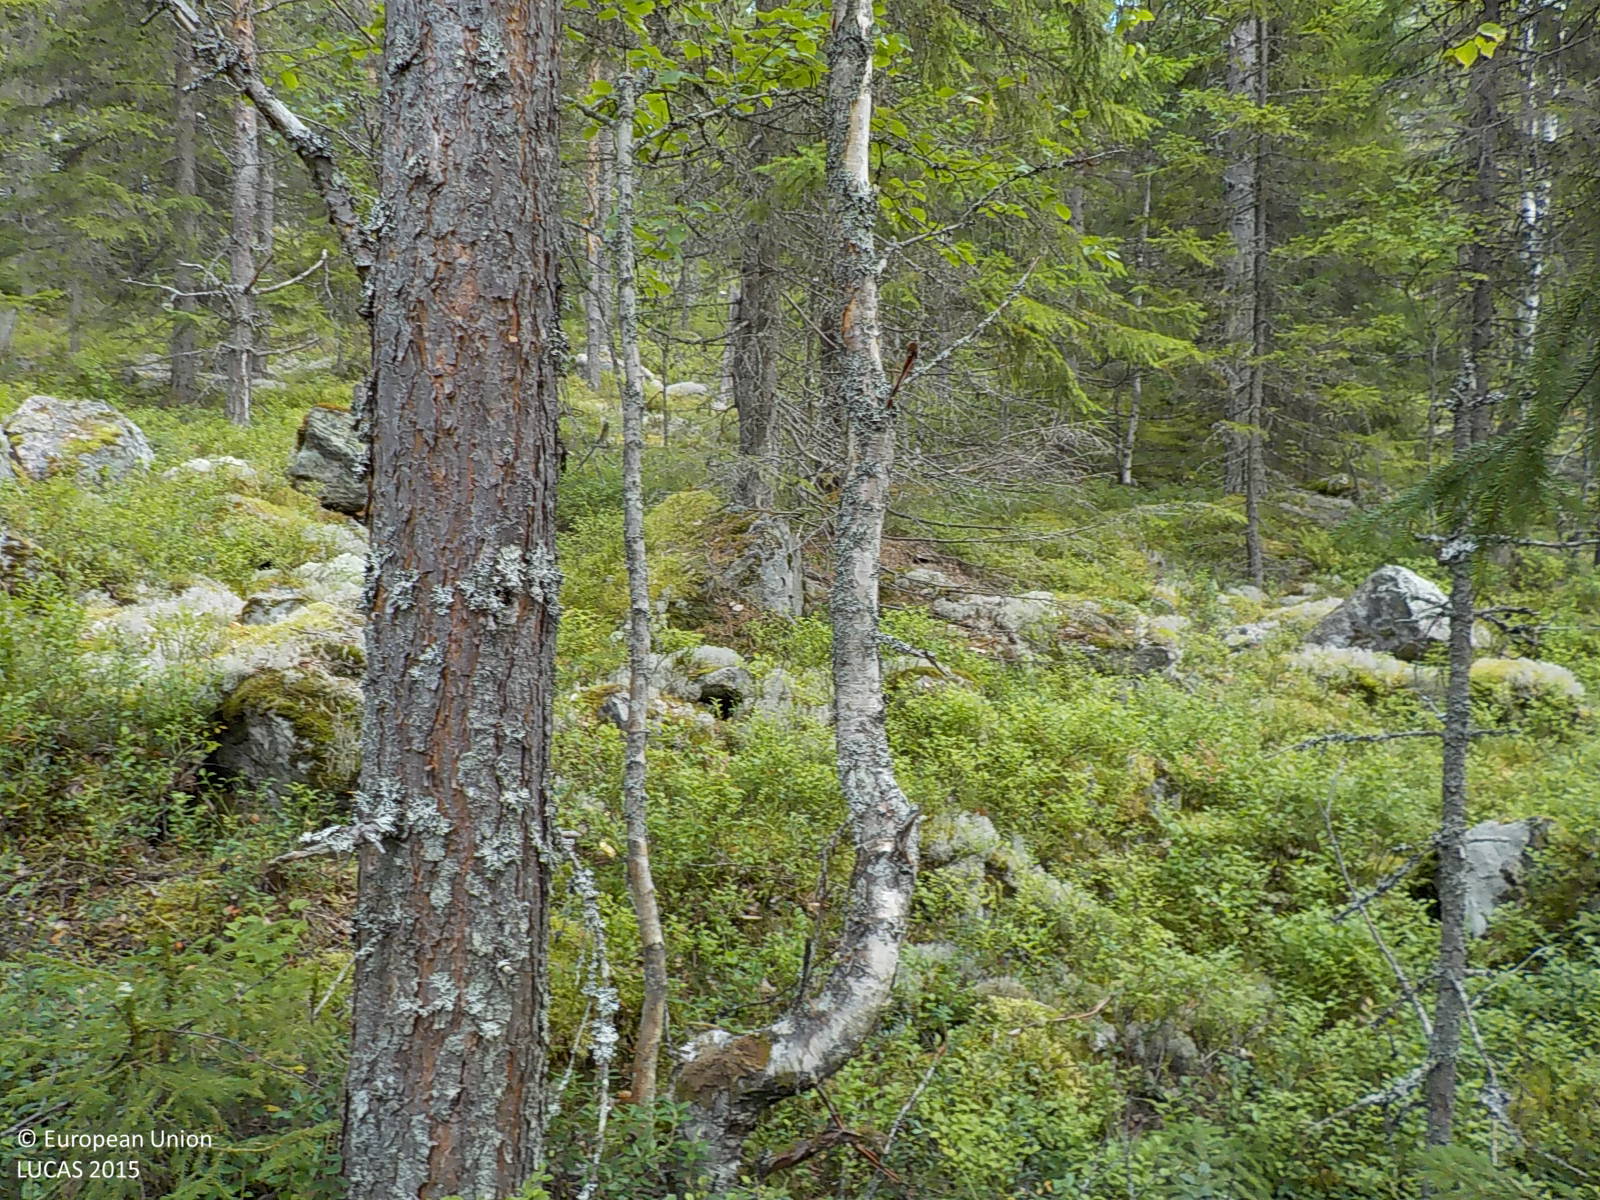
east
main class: Woodland
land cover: Pine dominated coniferous woodland
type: boreal forest
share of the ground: > 75 %
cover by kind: coniferous forest trees 80 %, shrubs 10 %, broadleaved forest trees 5 %, lichens and mosses 5 %
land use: Forestry
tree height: > 5 m
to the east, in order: Pine dominated coniferous woodland; Spruce dominated coniferous woodland; Pine dominated coniferous woodland
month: September
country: SE
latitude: 63.2443
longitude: 17.8008
